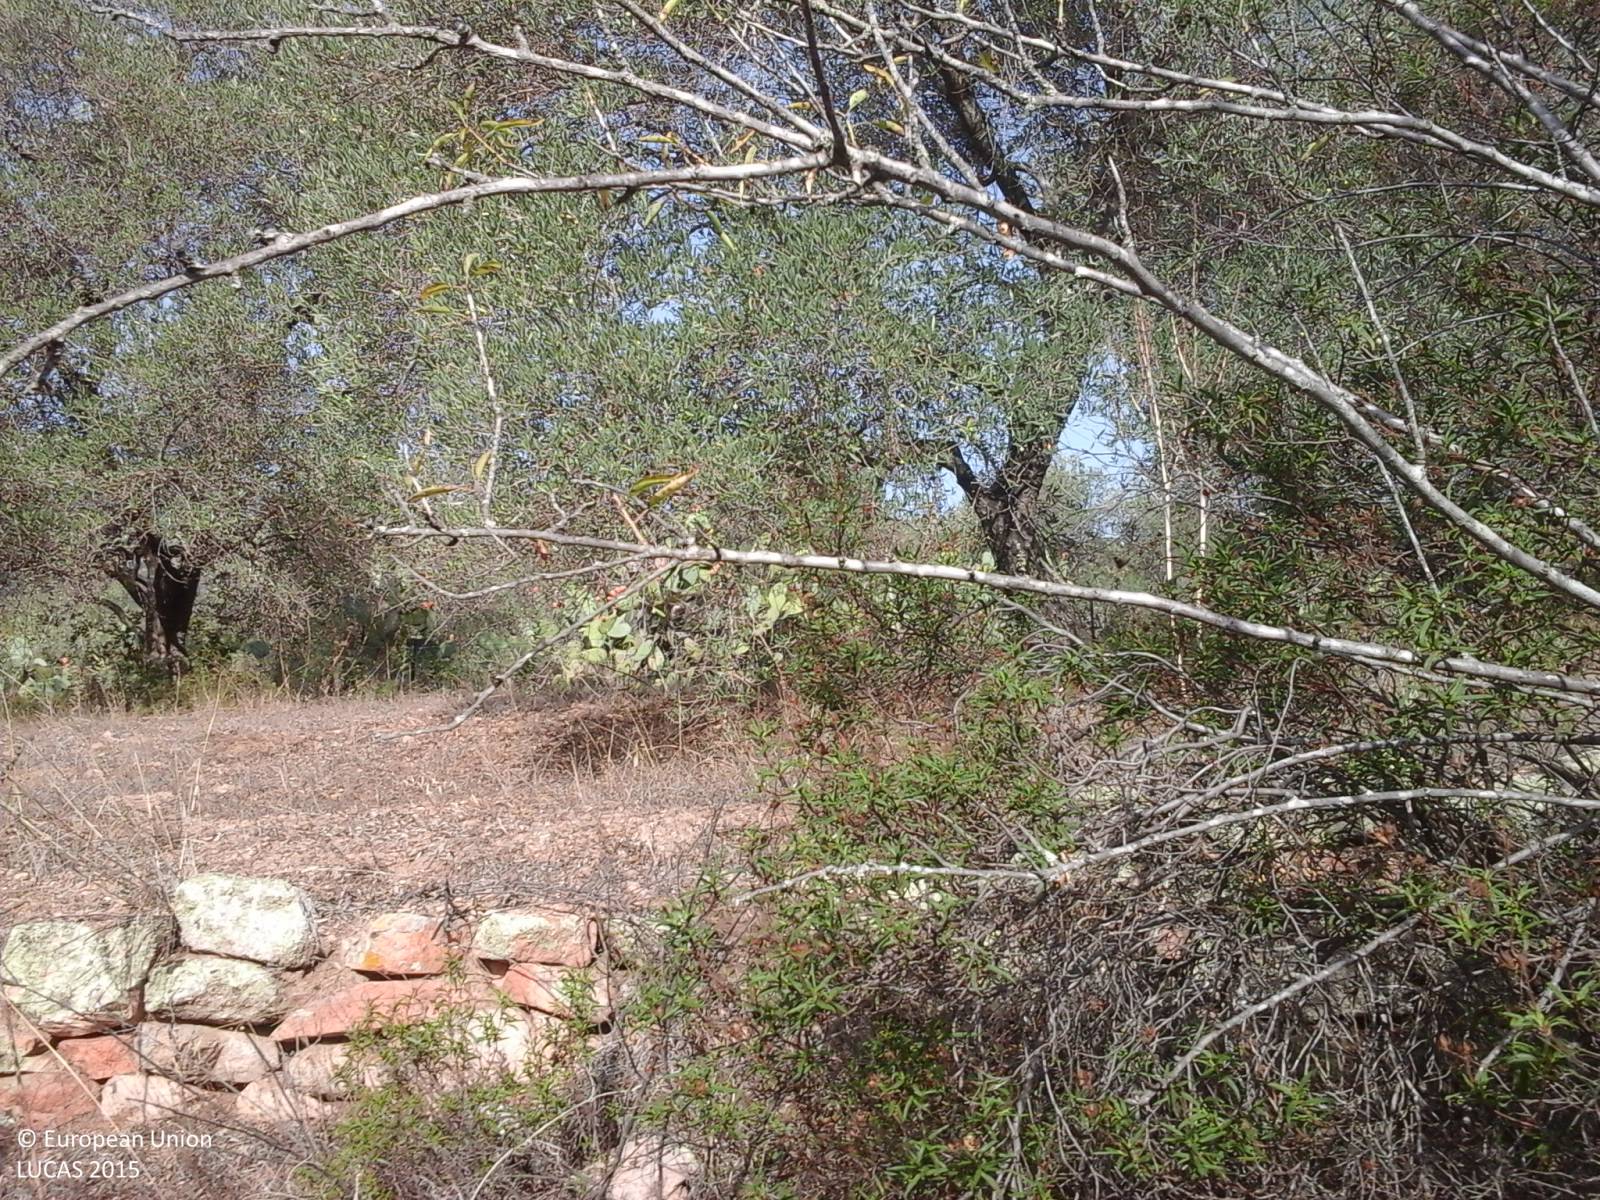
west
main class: Shrubland
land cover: Shrubland with sparse tree cover
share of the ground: > 75 %
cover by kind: shrubs 70 %, herbaceous plants 15 %, unconsolidated bare surface 10 %, broadleaved forest trees 5 %
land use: Semi-natural and natural areas not in use
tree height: > 5 m
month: September
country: IT
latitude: 39.9767
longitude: 9.5691
